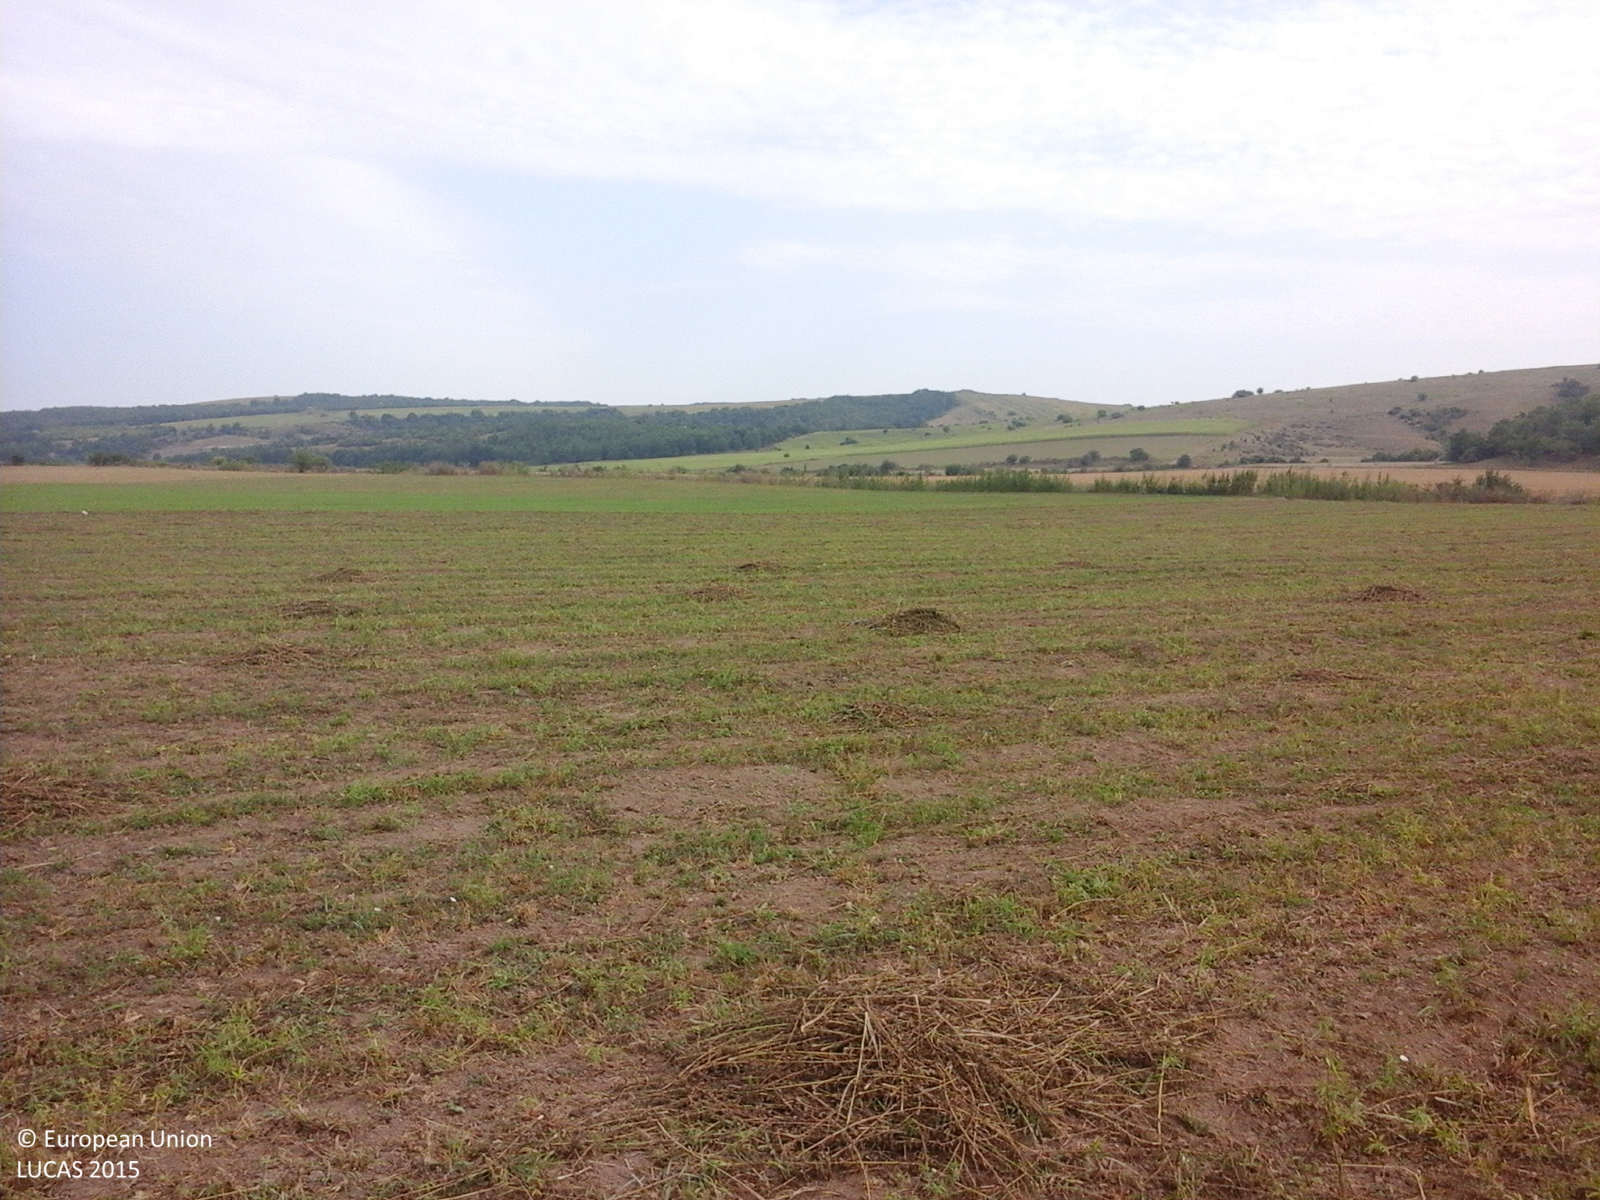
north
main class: Cropland
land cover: Lucerne
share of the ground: 10 - 25 %
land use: Agriculture (excluding fallow land and kitchen gardens)
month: August
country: RO
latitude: 44.1231
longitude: 27.9085
